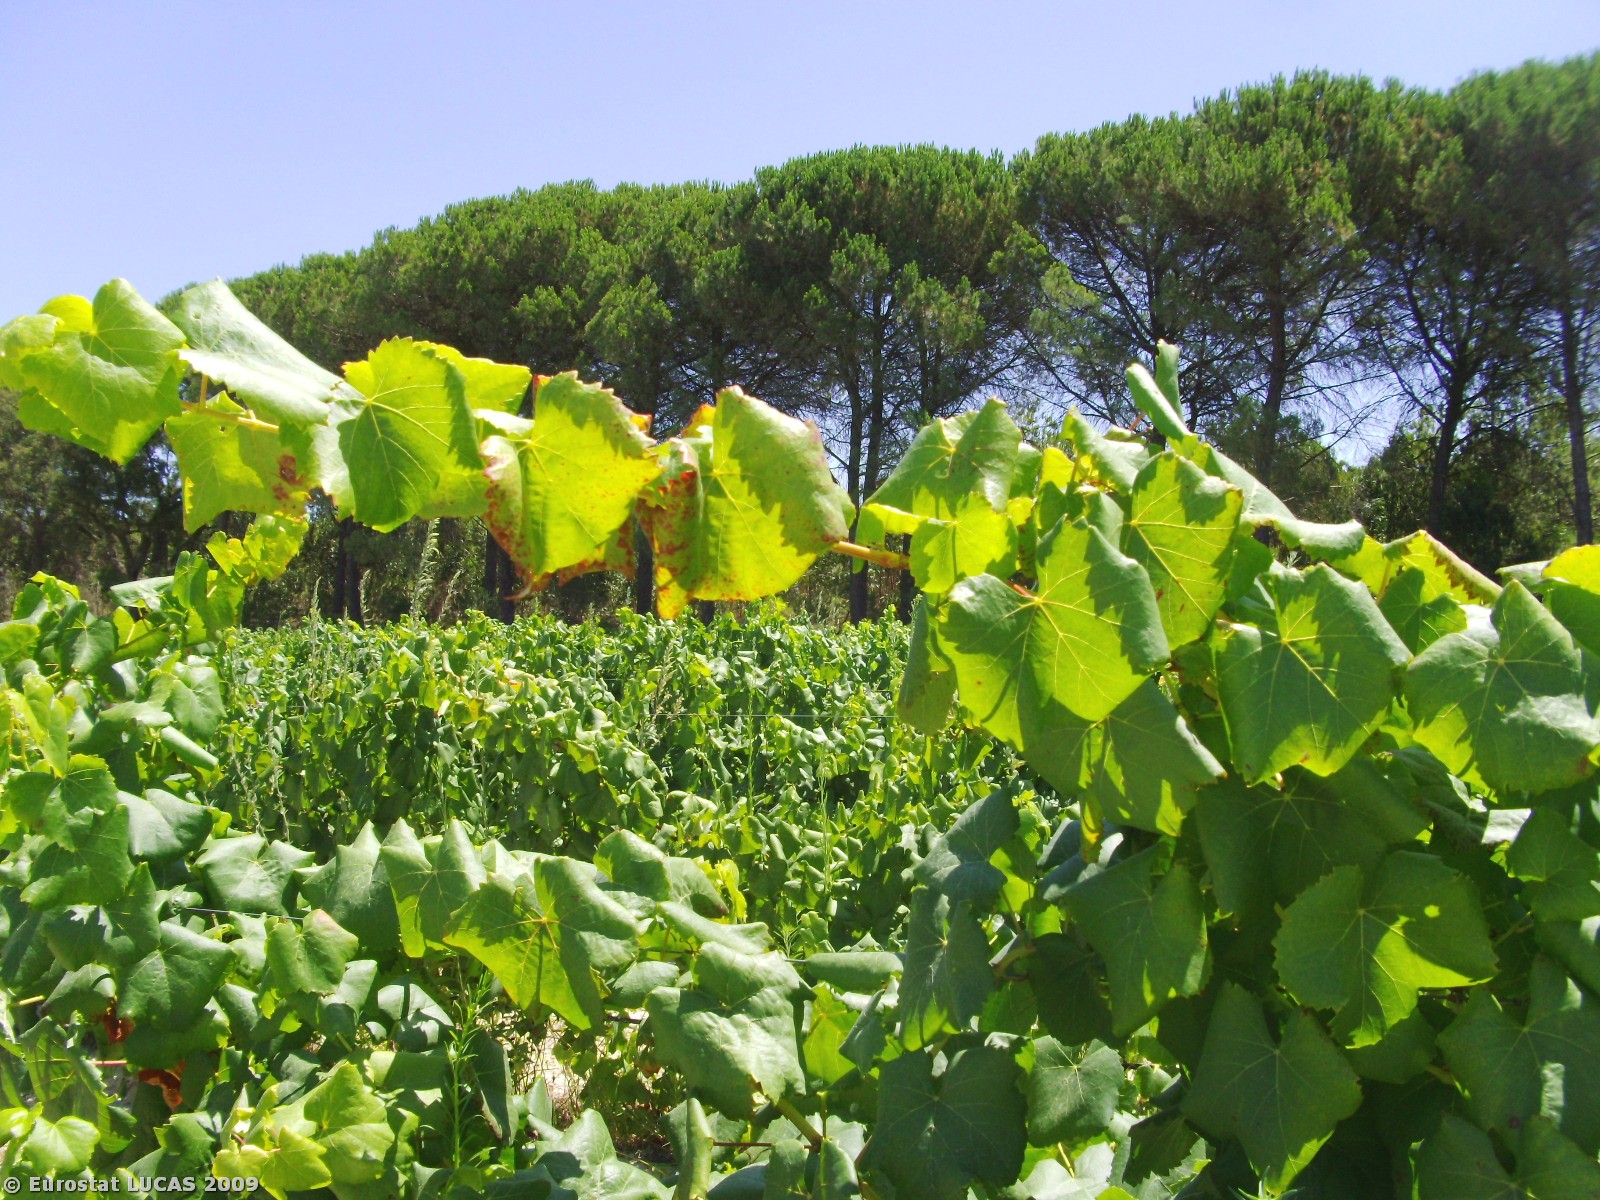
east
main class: Cropland
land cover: Vineyards
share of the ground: 25 - 50 %
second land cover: Bare land
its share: 50 - 75 %
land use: Agriculture (excluding fallow land and kitchen gardens)
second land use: Fallow land
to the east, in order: Vineyards; Bare land; Vineyards; Bare land; Coniferous woodland; Tracks; Coniferous woodland; Mixed woodland
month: August
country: PT
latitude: 38.6614
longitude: -8.6664
